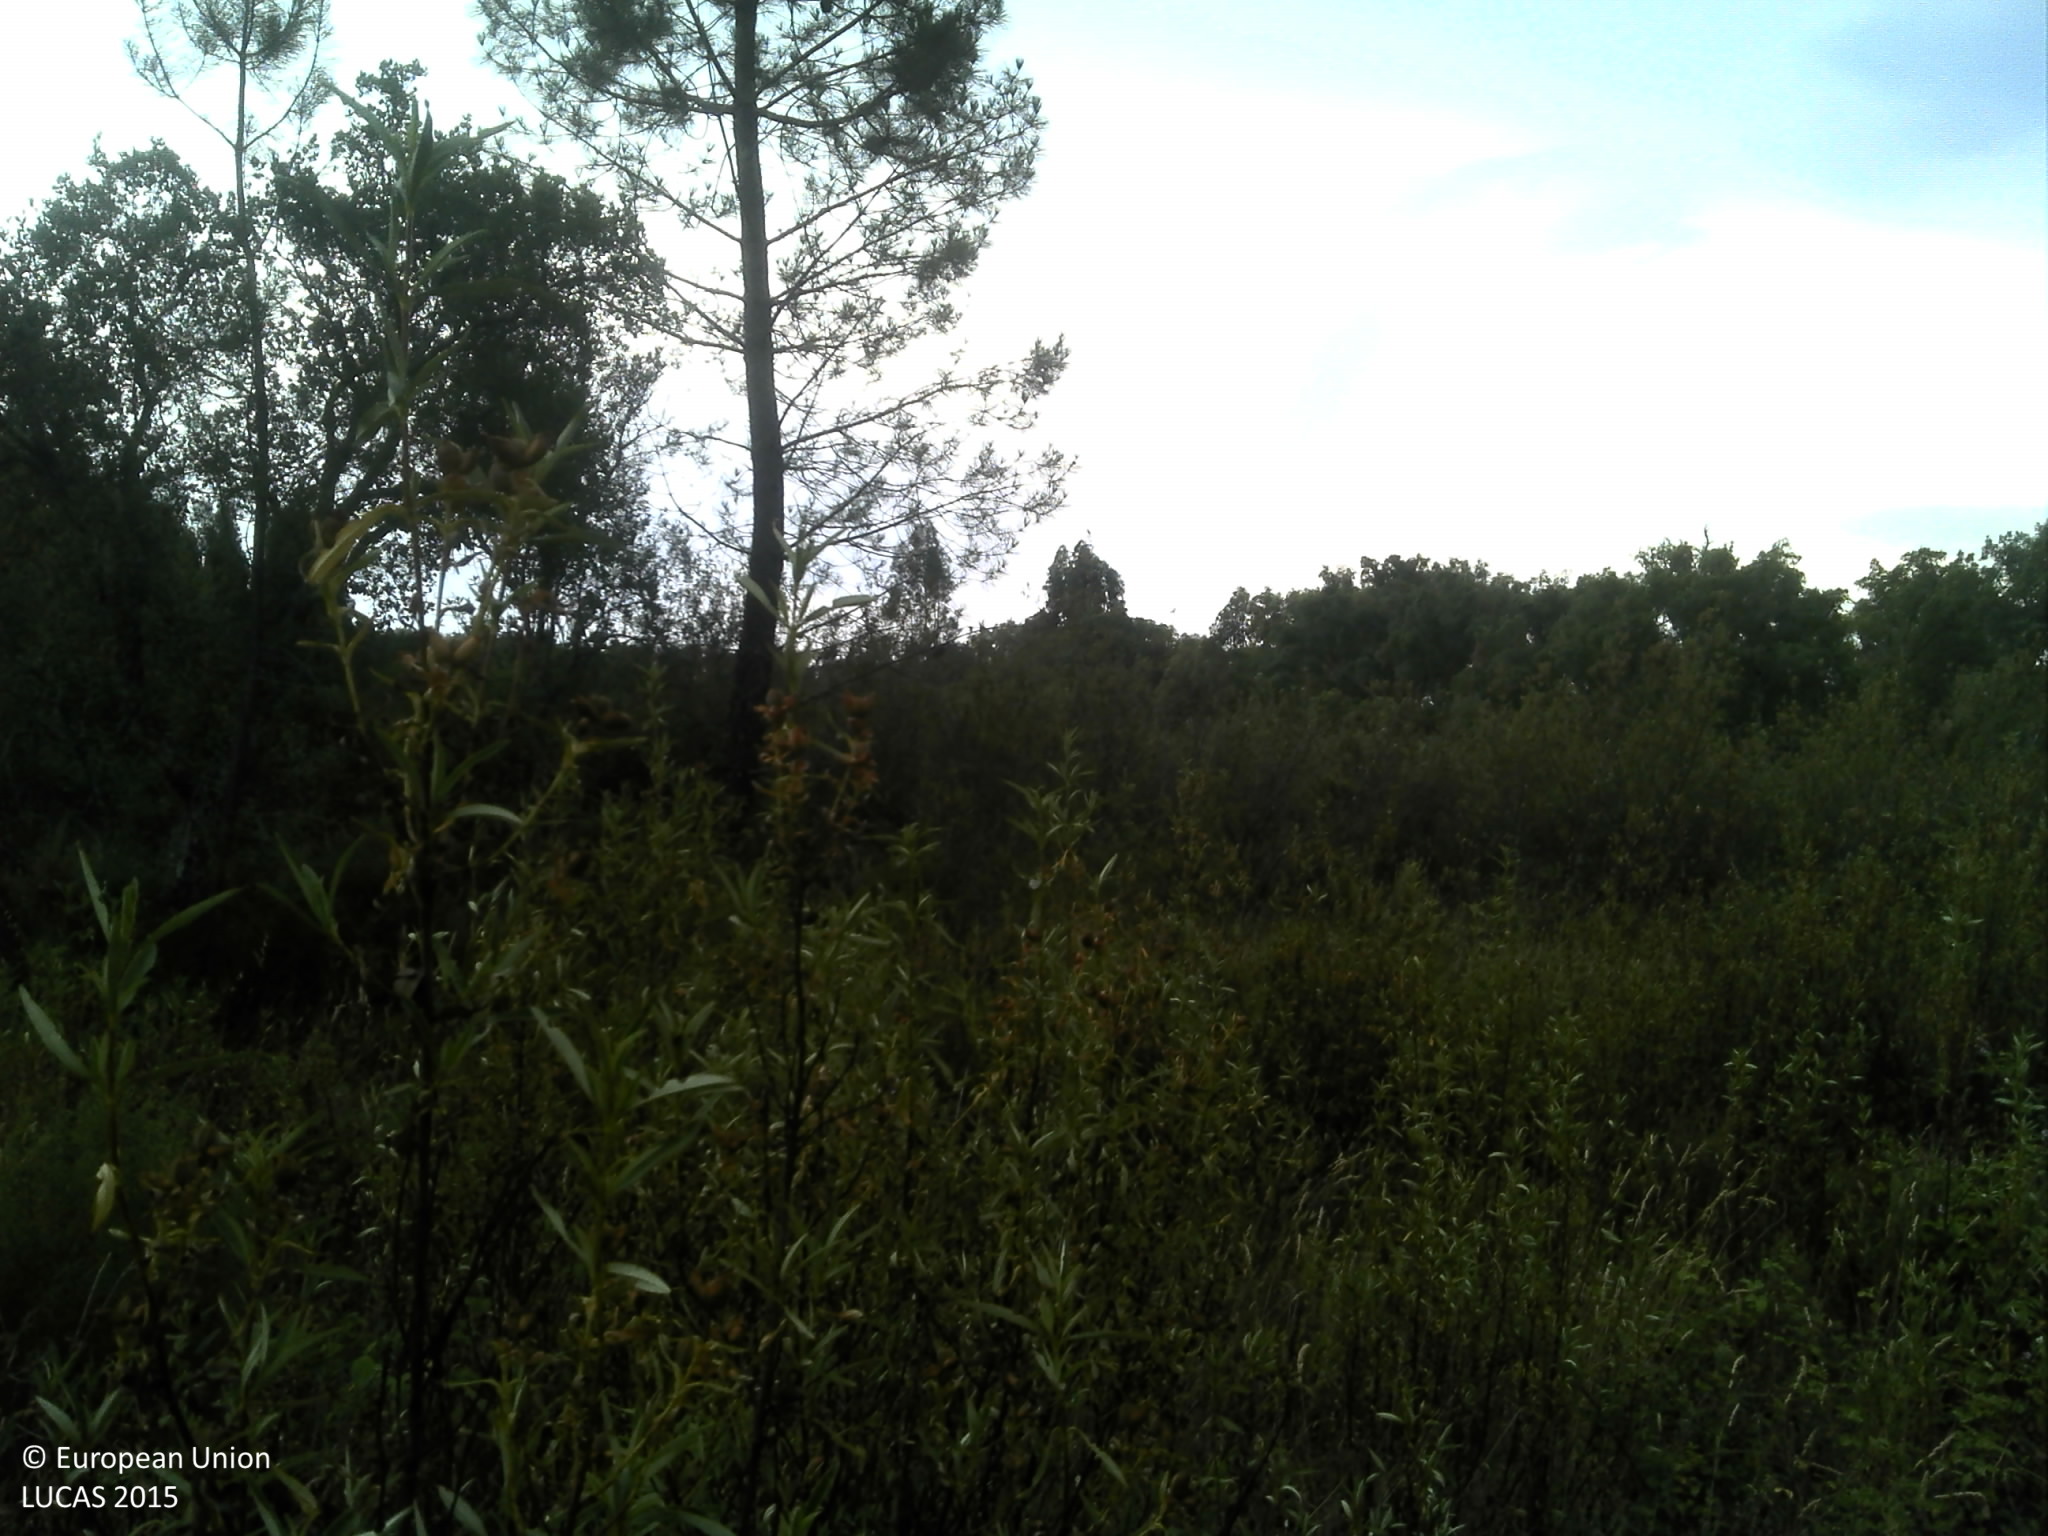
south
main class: Woodland
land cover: Broadleaved woodland
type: broadleaved evergreen forest
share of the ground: 10 - 25 %
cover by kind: shrubs 50 %, broadleaved forest trees 25 %, unconsolidated bare surface 15 %, herbaceous plants 10 %
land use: Forestry
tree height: > 5 m
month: June
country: PT
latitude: 39.3702
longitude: -8.0615
